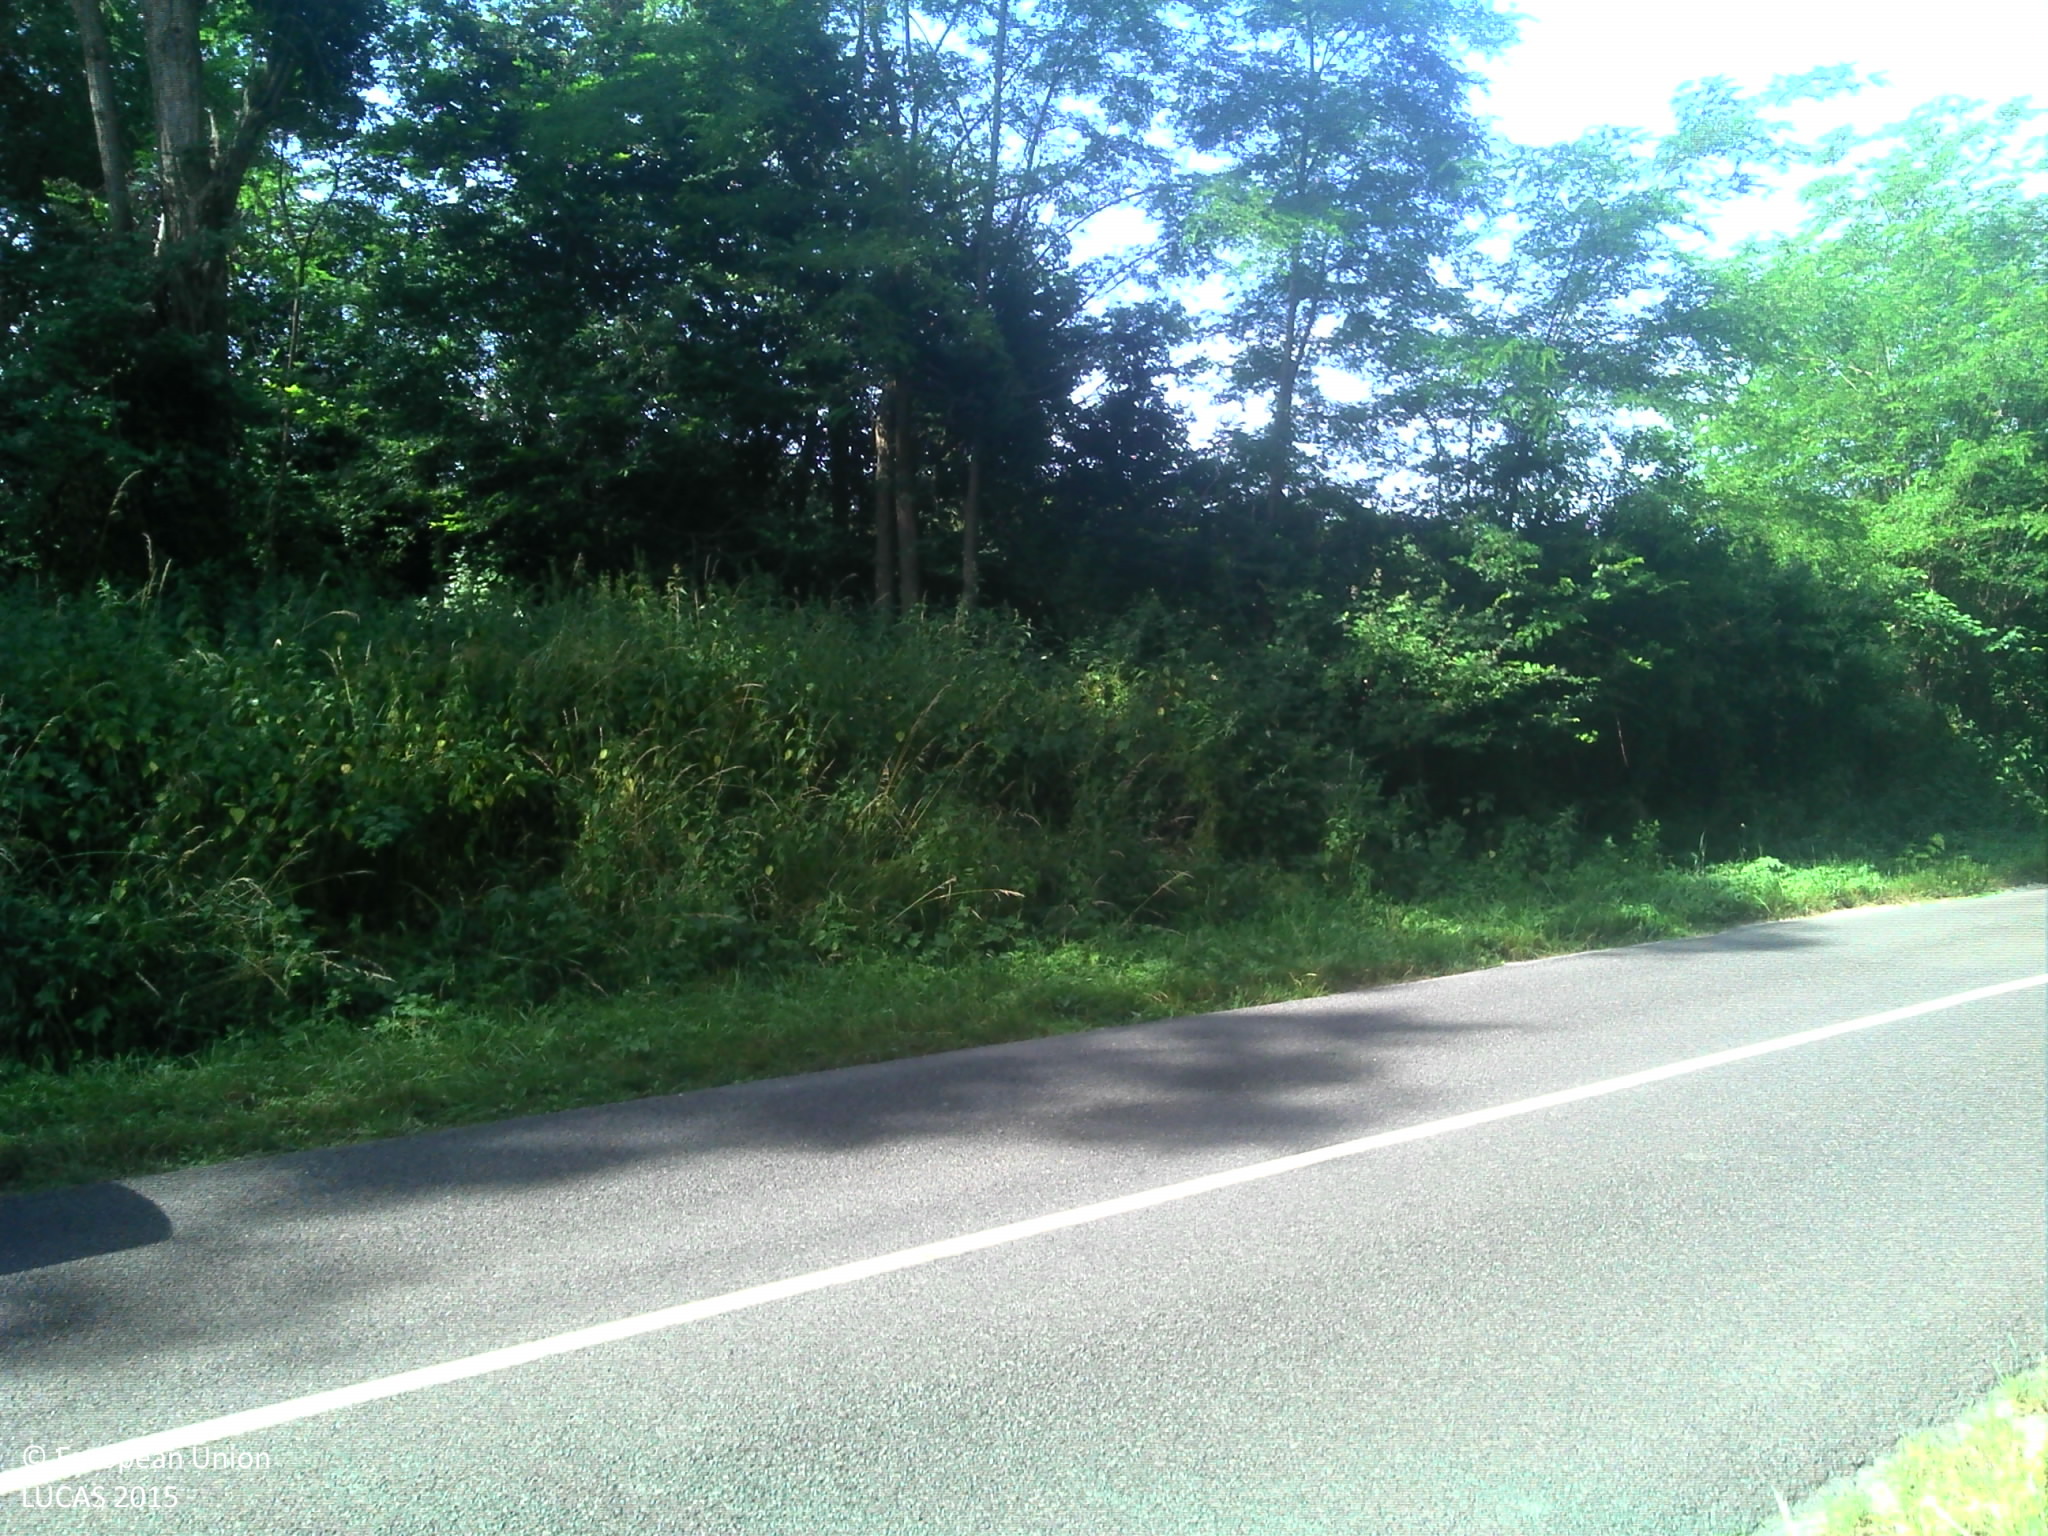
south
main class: Woodland
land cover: Broadleaved woodland
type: mesophytic deciduous forest
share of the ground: > 75 %
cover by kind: herbaceous plants 40 %, unconsolidated bare surface 40 %, broadleaved forest trees 20 %
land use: Forestry
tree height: > 5 m
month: June
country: FR
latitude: 47.5024
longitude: 1.3425
